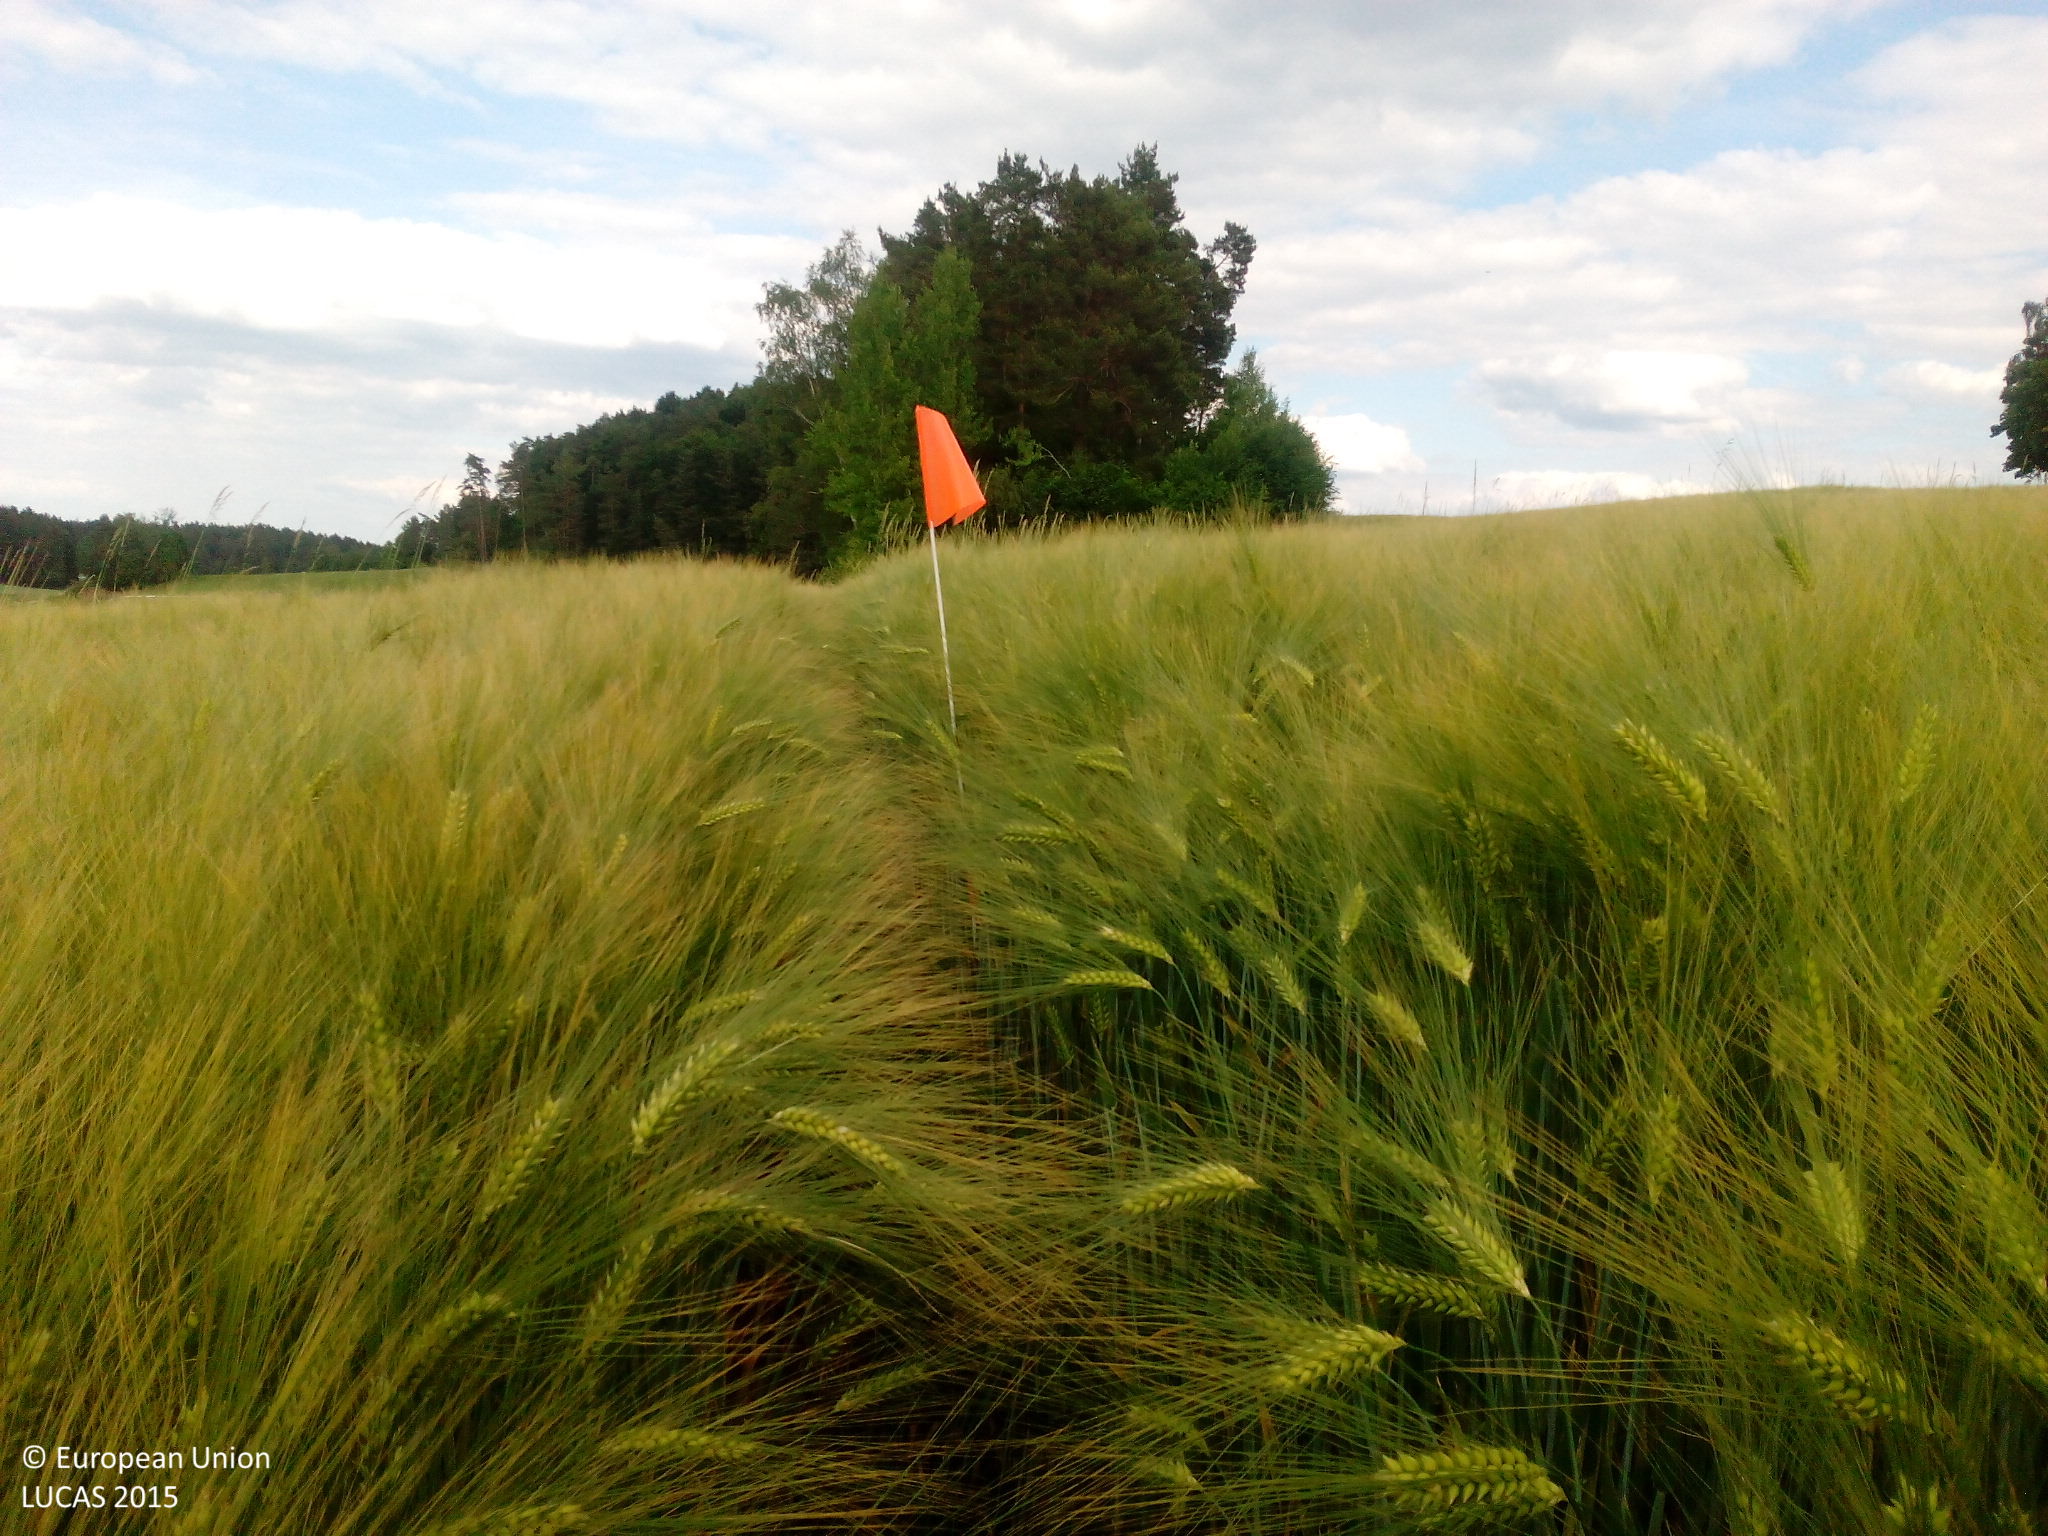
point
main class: Cropland
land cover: Barley
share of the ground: > 75 %
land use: Agriculture (excluding fallow land and kitchen gardens)
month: June
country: DE
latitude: 49.6713
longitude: 11.4545
